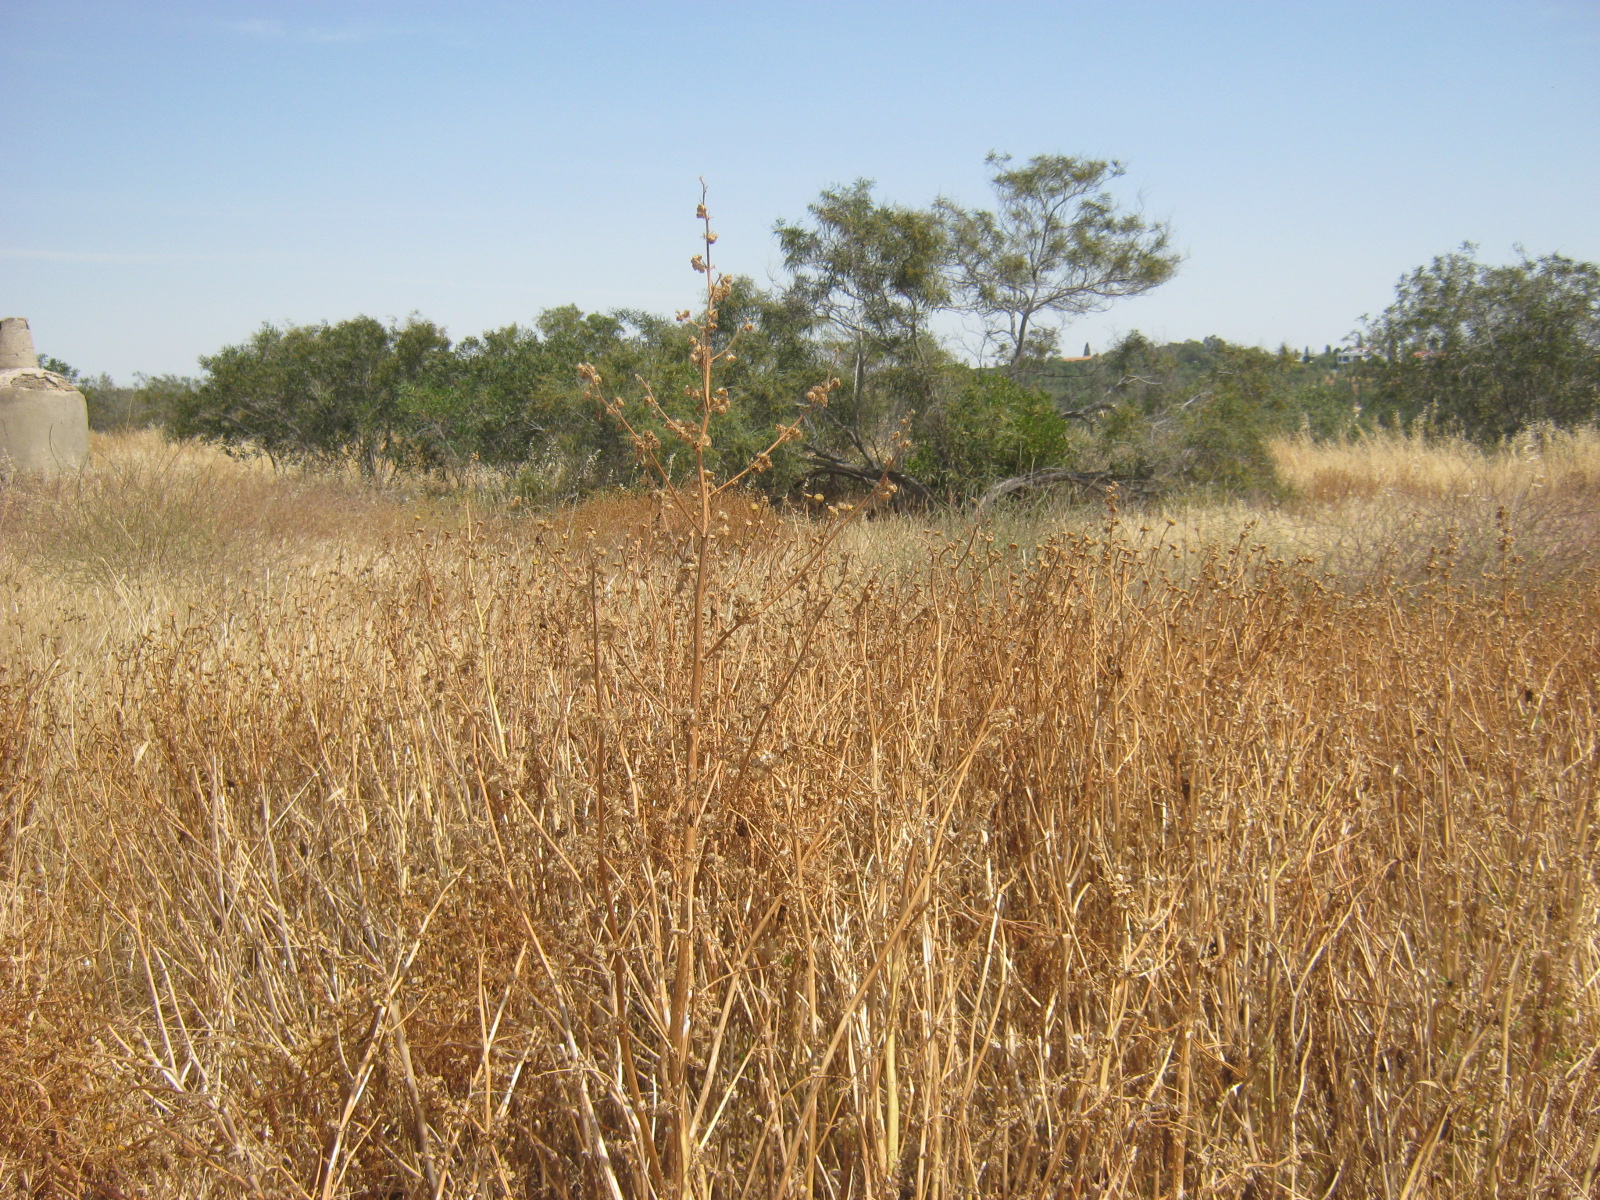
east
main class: Grassland
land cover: Grassland with sparse tree/shrub cover
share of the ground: > 75 %
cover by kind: herbaceous plants 90 %, broadleaved forest trees 5 %, shrubs 5 %
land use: Semi-natural and natural areas not in use
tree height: < 5 m
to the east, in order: Grassland with sparse tree/shrub cover; Tracks; Grassland with sparse tree/shrub cover; Pine dominated coniferous woodland; Tracks; Grassland with sparse tree/shrub cover; Tracks; Pine dominated mixed woodland
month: May
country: CY
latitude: 35.1274
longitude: 33.3810
